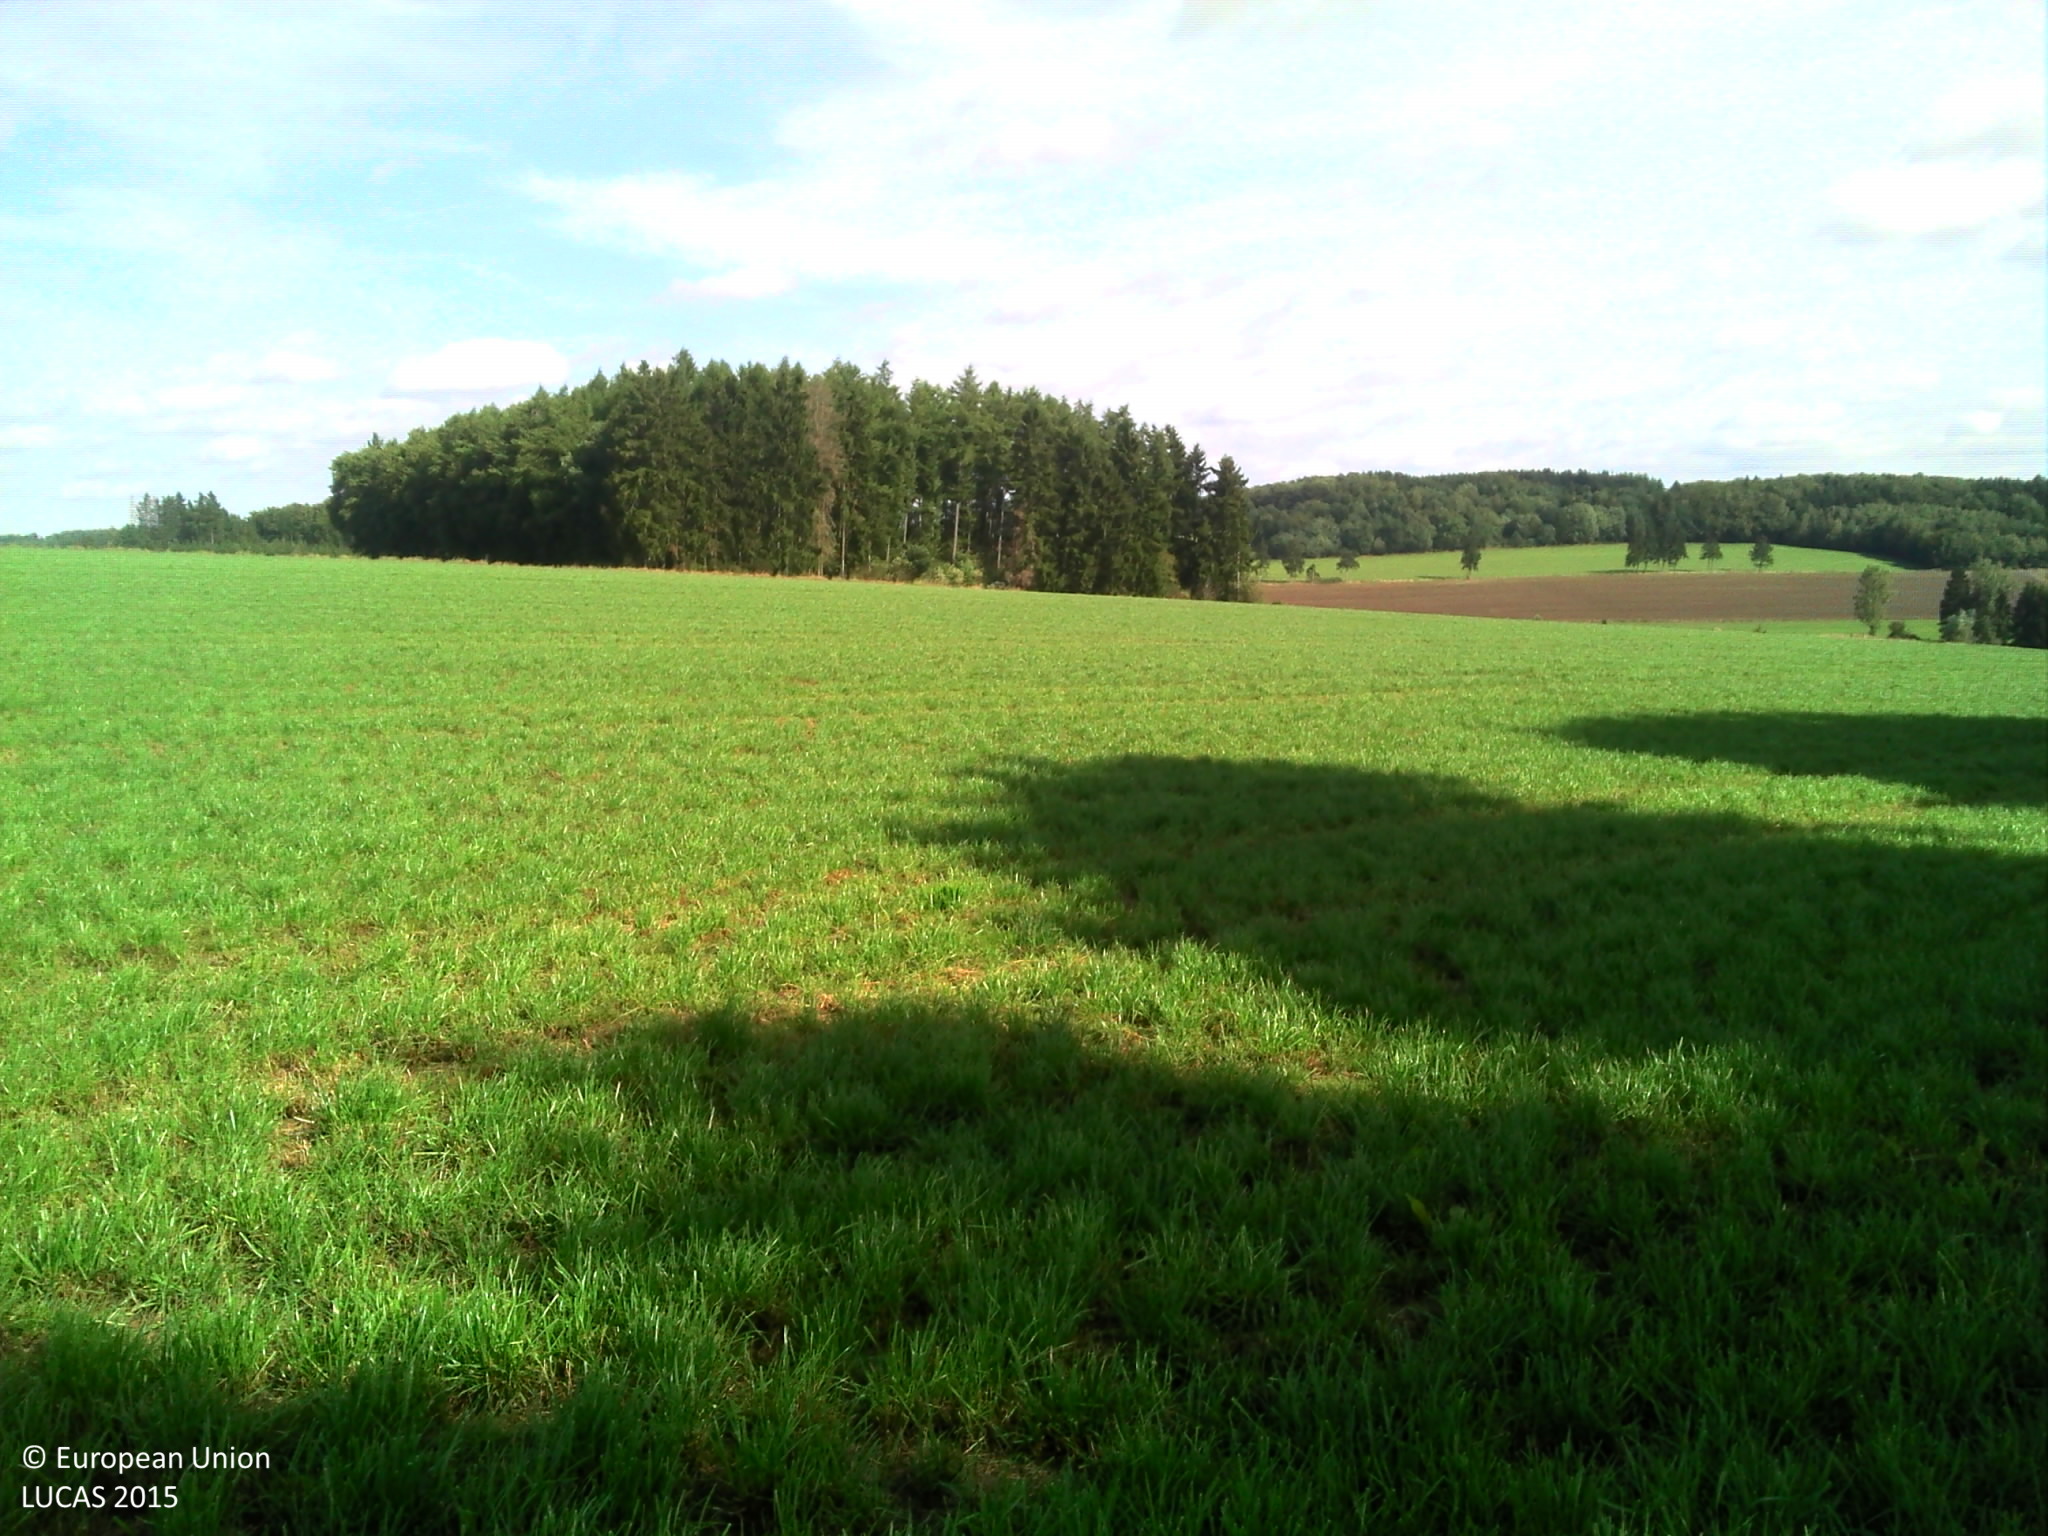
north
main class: Cropland
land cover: Temporary grasslands
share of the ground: > 75 %
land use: Agriculture (excluding fallow land and kitchen gardens)
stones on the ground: < 10 %
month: August
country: LU
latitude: 50.0747
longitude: 5.9049
